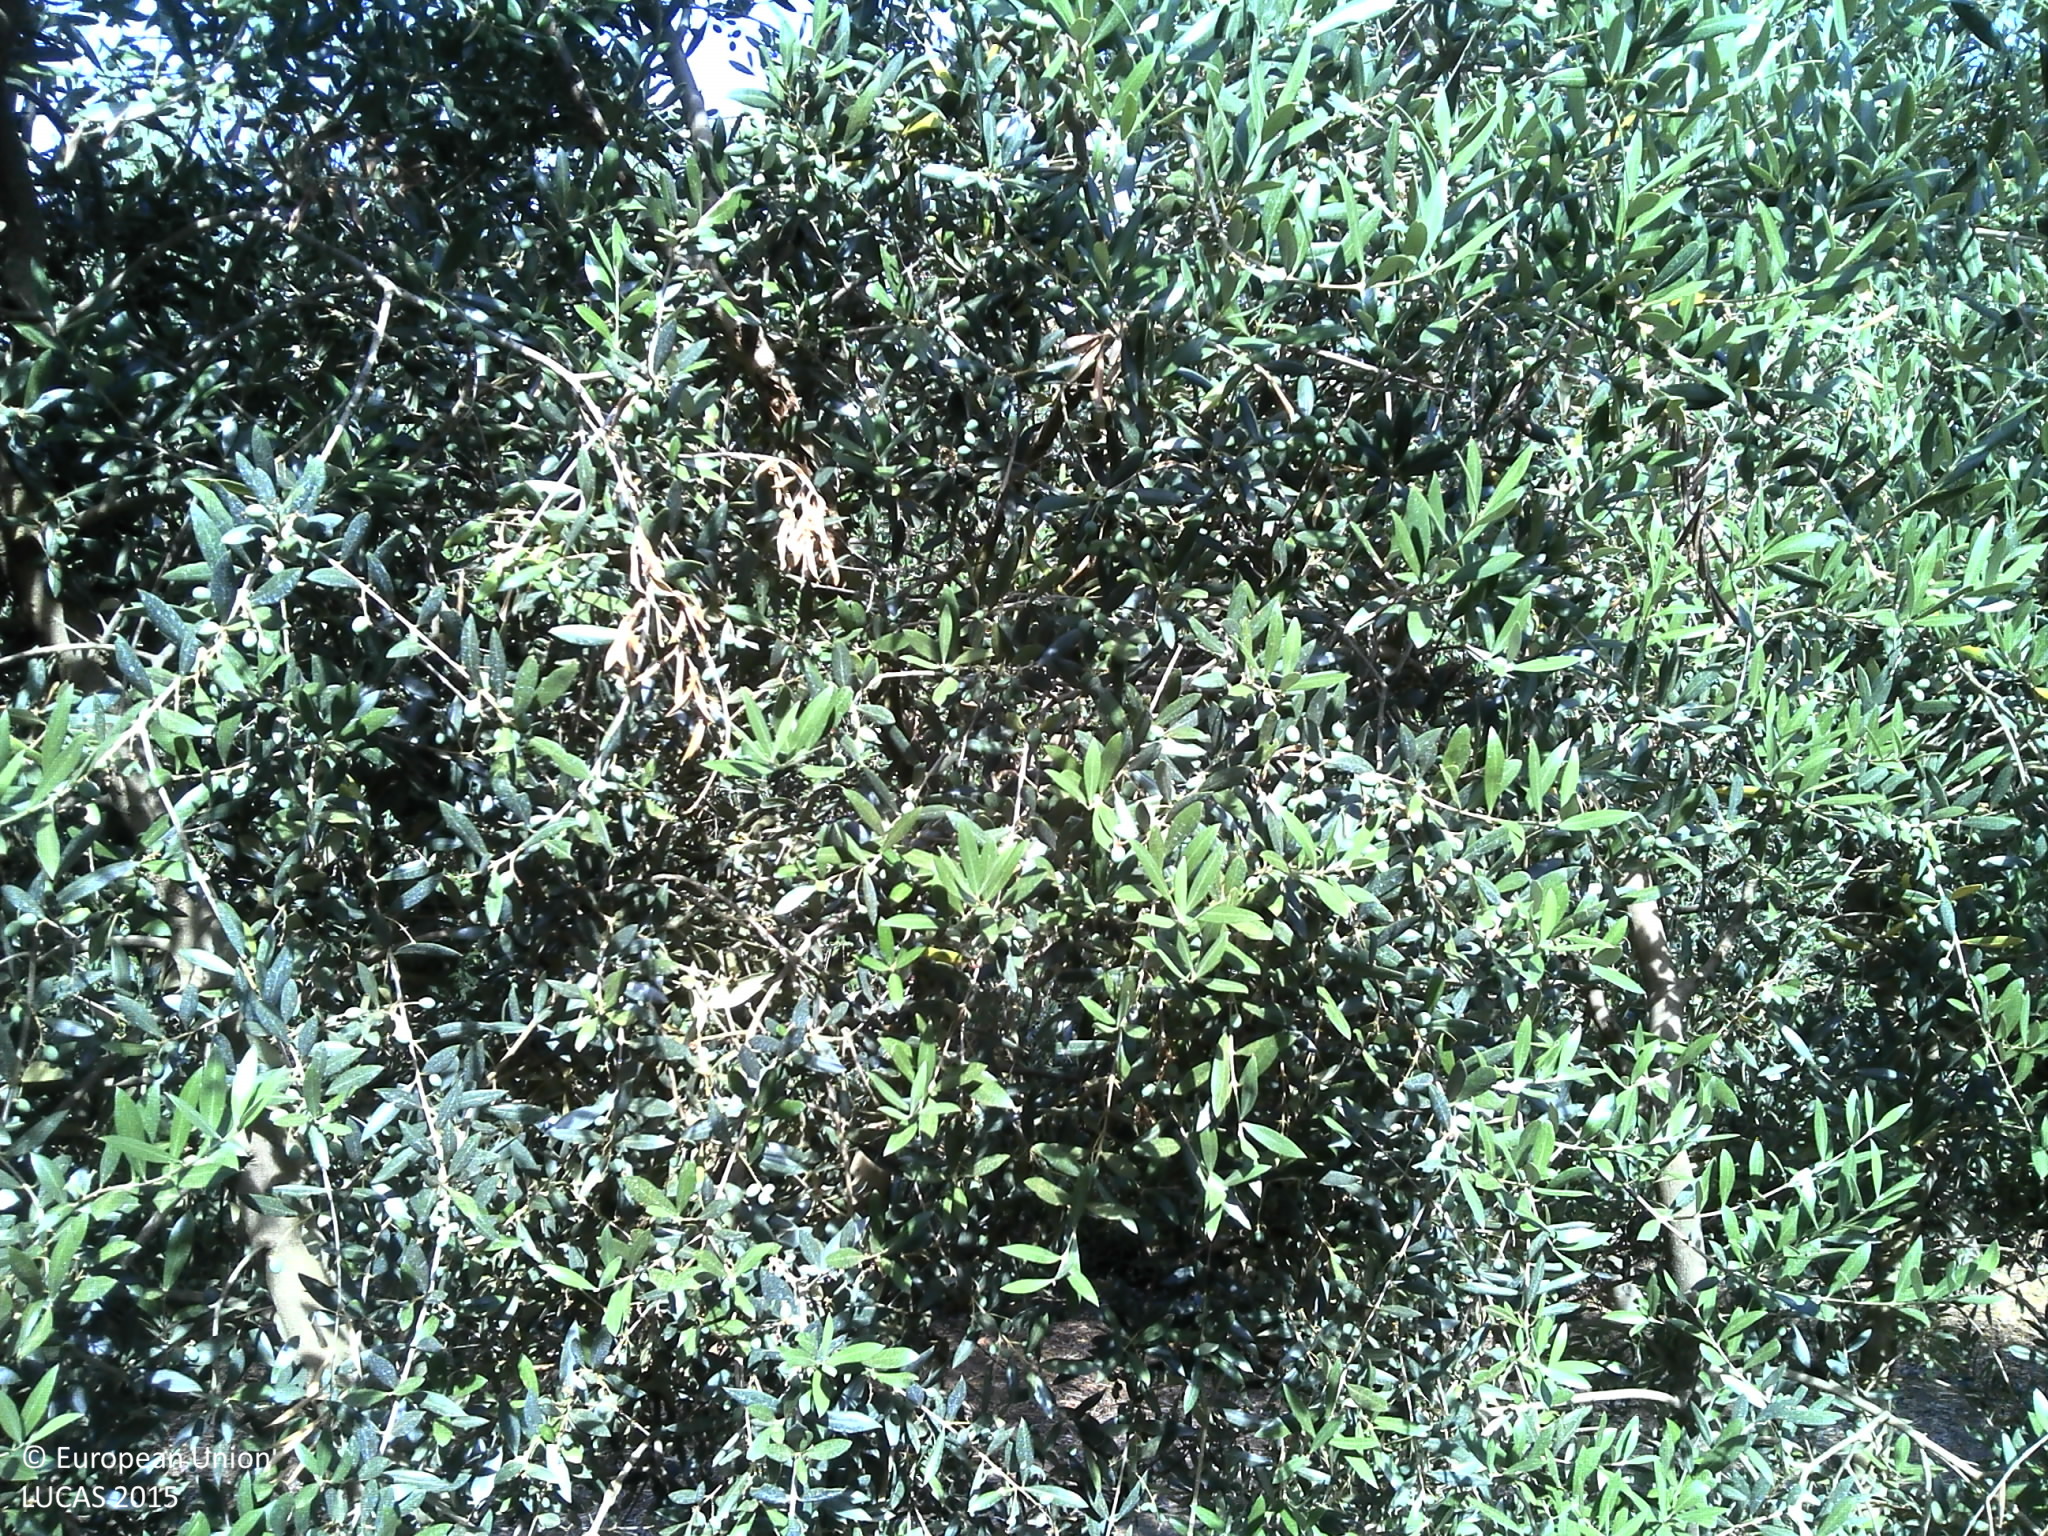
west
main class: Cropland
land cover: Olive groves
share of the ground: 50 - 75 %
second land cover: Grassland without tree/shrub cover
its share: 25 - 50 %
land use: Agriculture (excluding fallow land and kitchen gardens)
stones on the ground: < 10 %
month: July
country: PT
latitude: 38.4166
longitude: -7.7274
